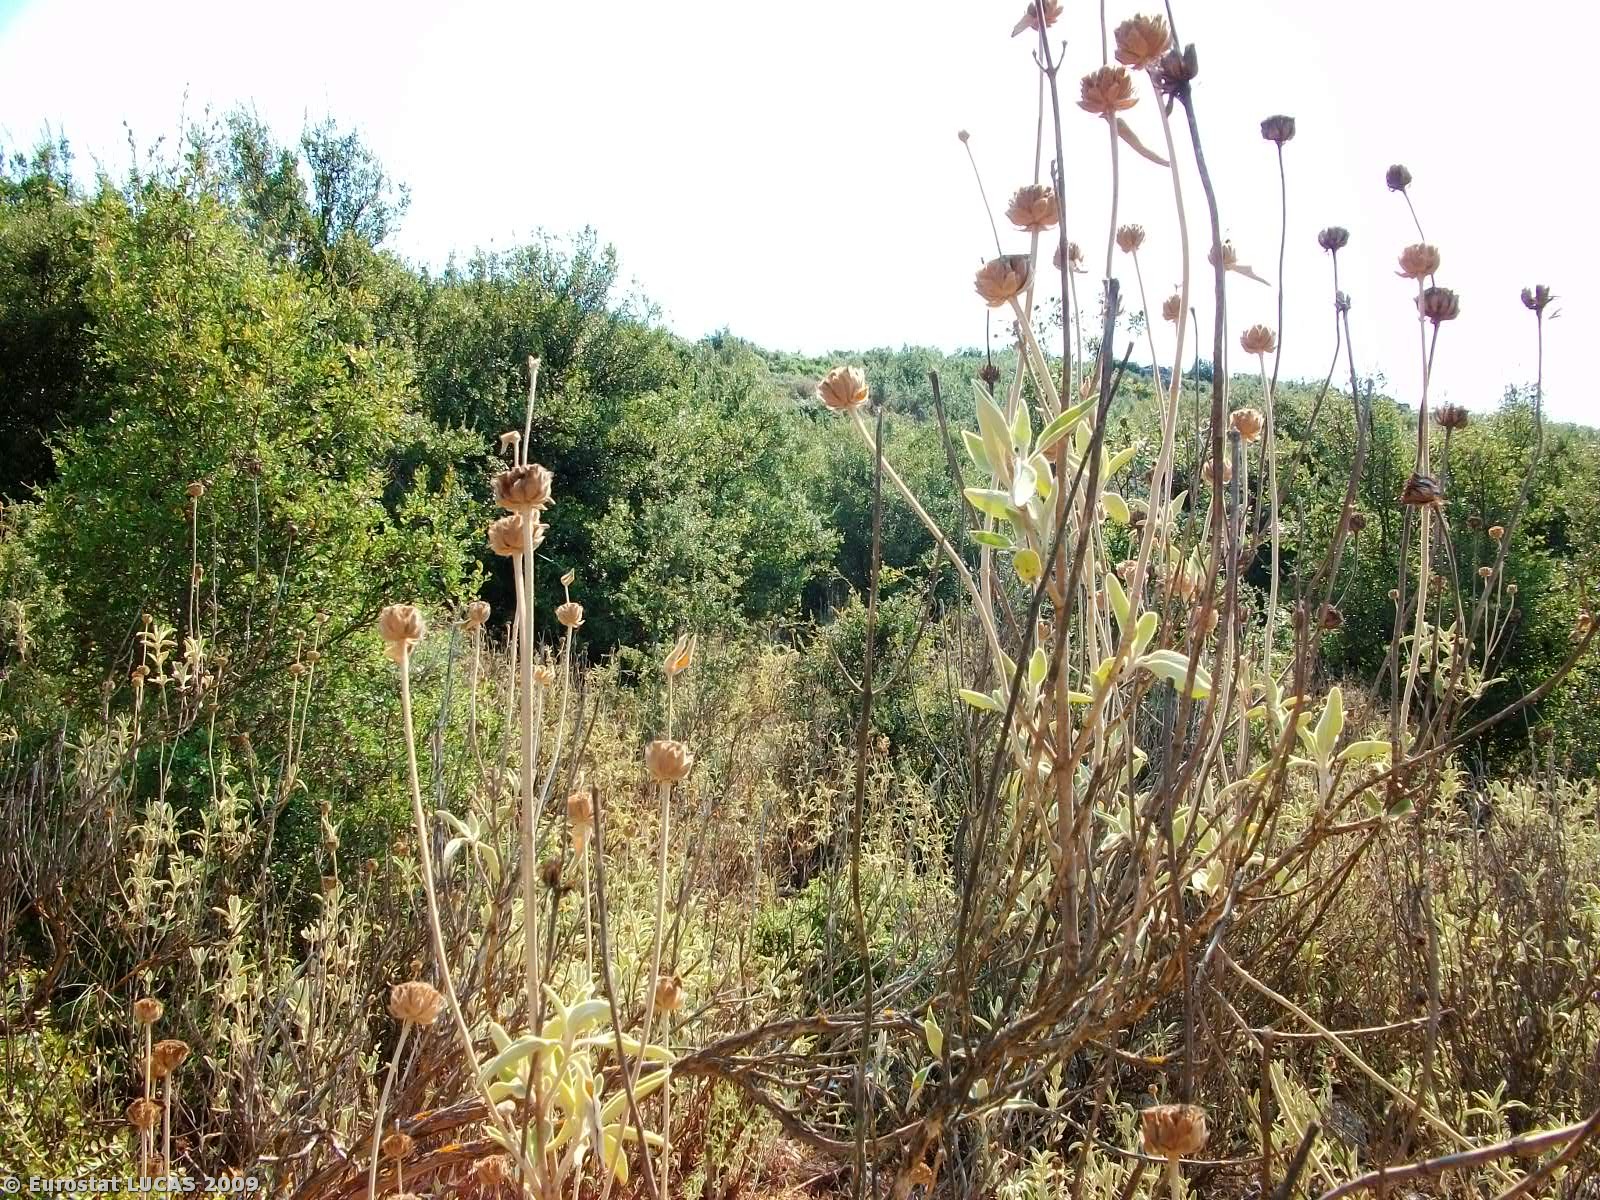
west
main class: Shrubland
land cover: Shrubland with sparse tree cover
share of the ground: > 75 %
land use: Agriculture (excluding fallow land and kitchen gardens)
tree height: < 5 m
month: August
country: GR
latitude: 39.3225
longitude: 20.4705
